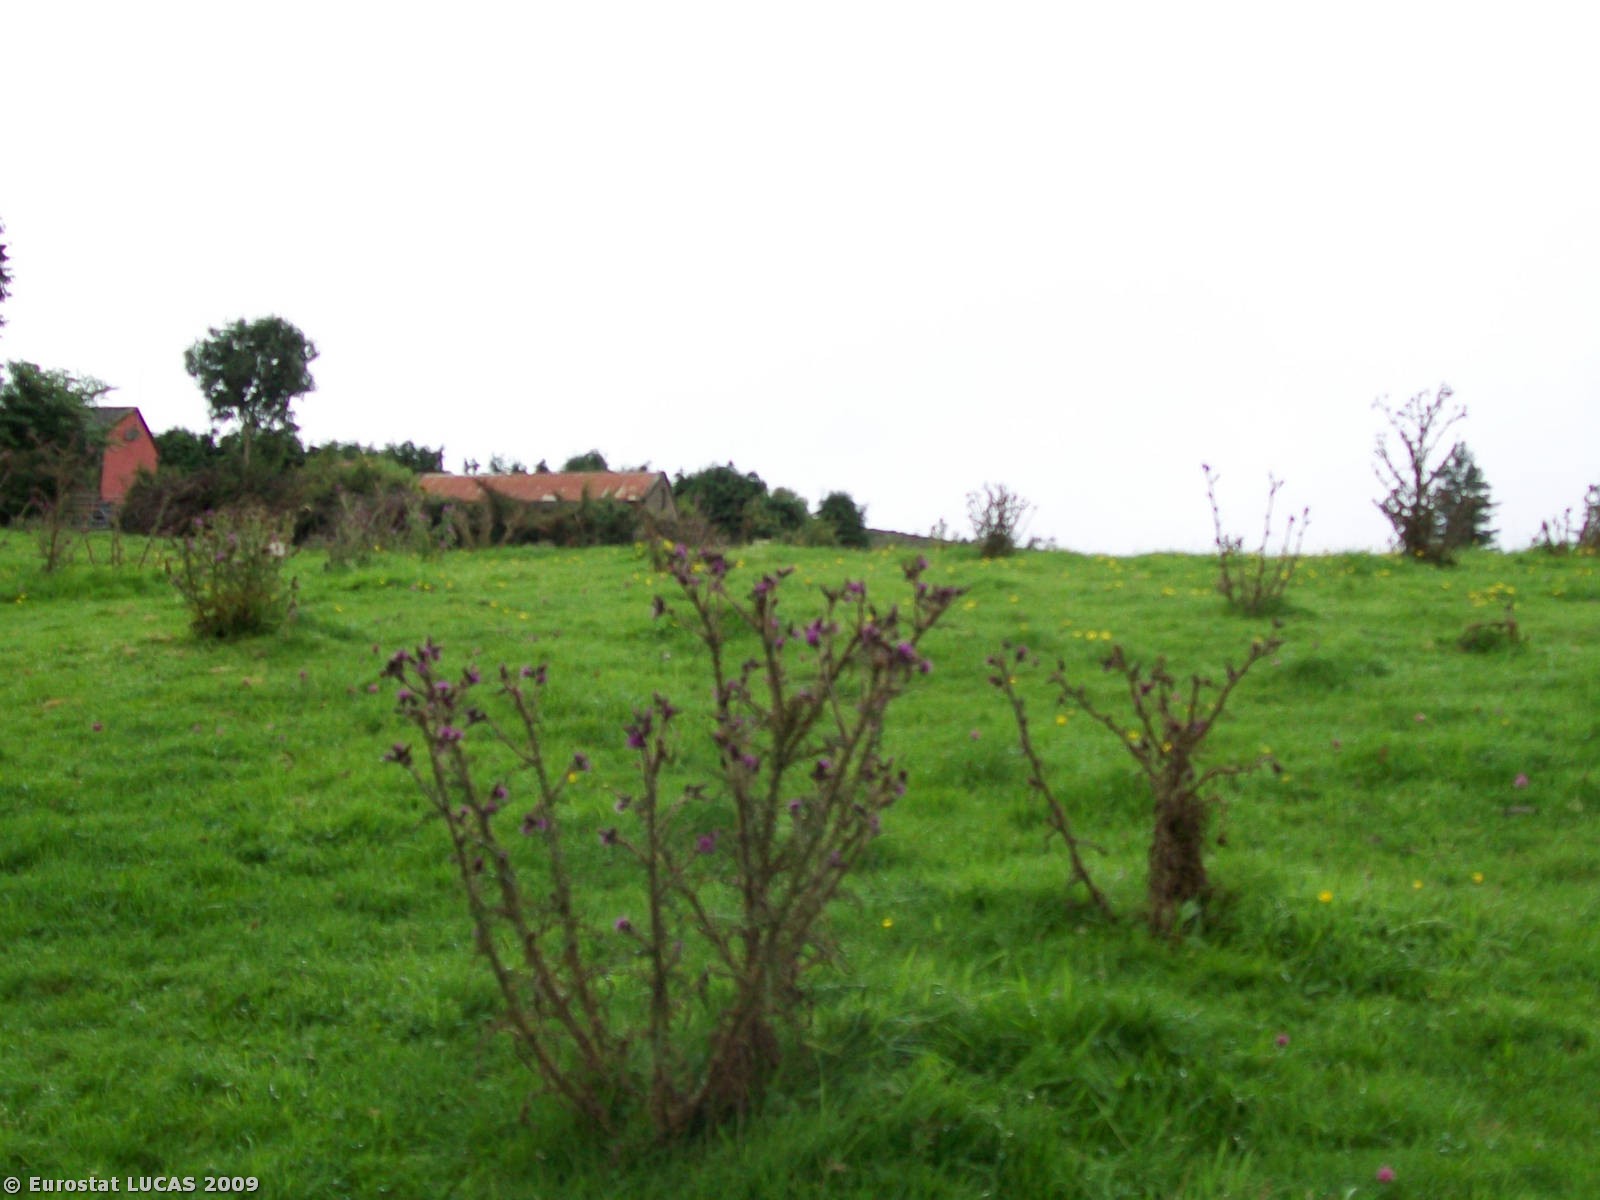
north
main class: Grassland
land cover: Grassland with sparse tree/shrub cover
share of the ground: > 75 %
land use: Agriculture (excluding fallow land and kitchen gardens)
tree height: < 5 m
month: August
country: IE
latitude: 52.8089
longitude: -8.6083
